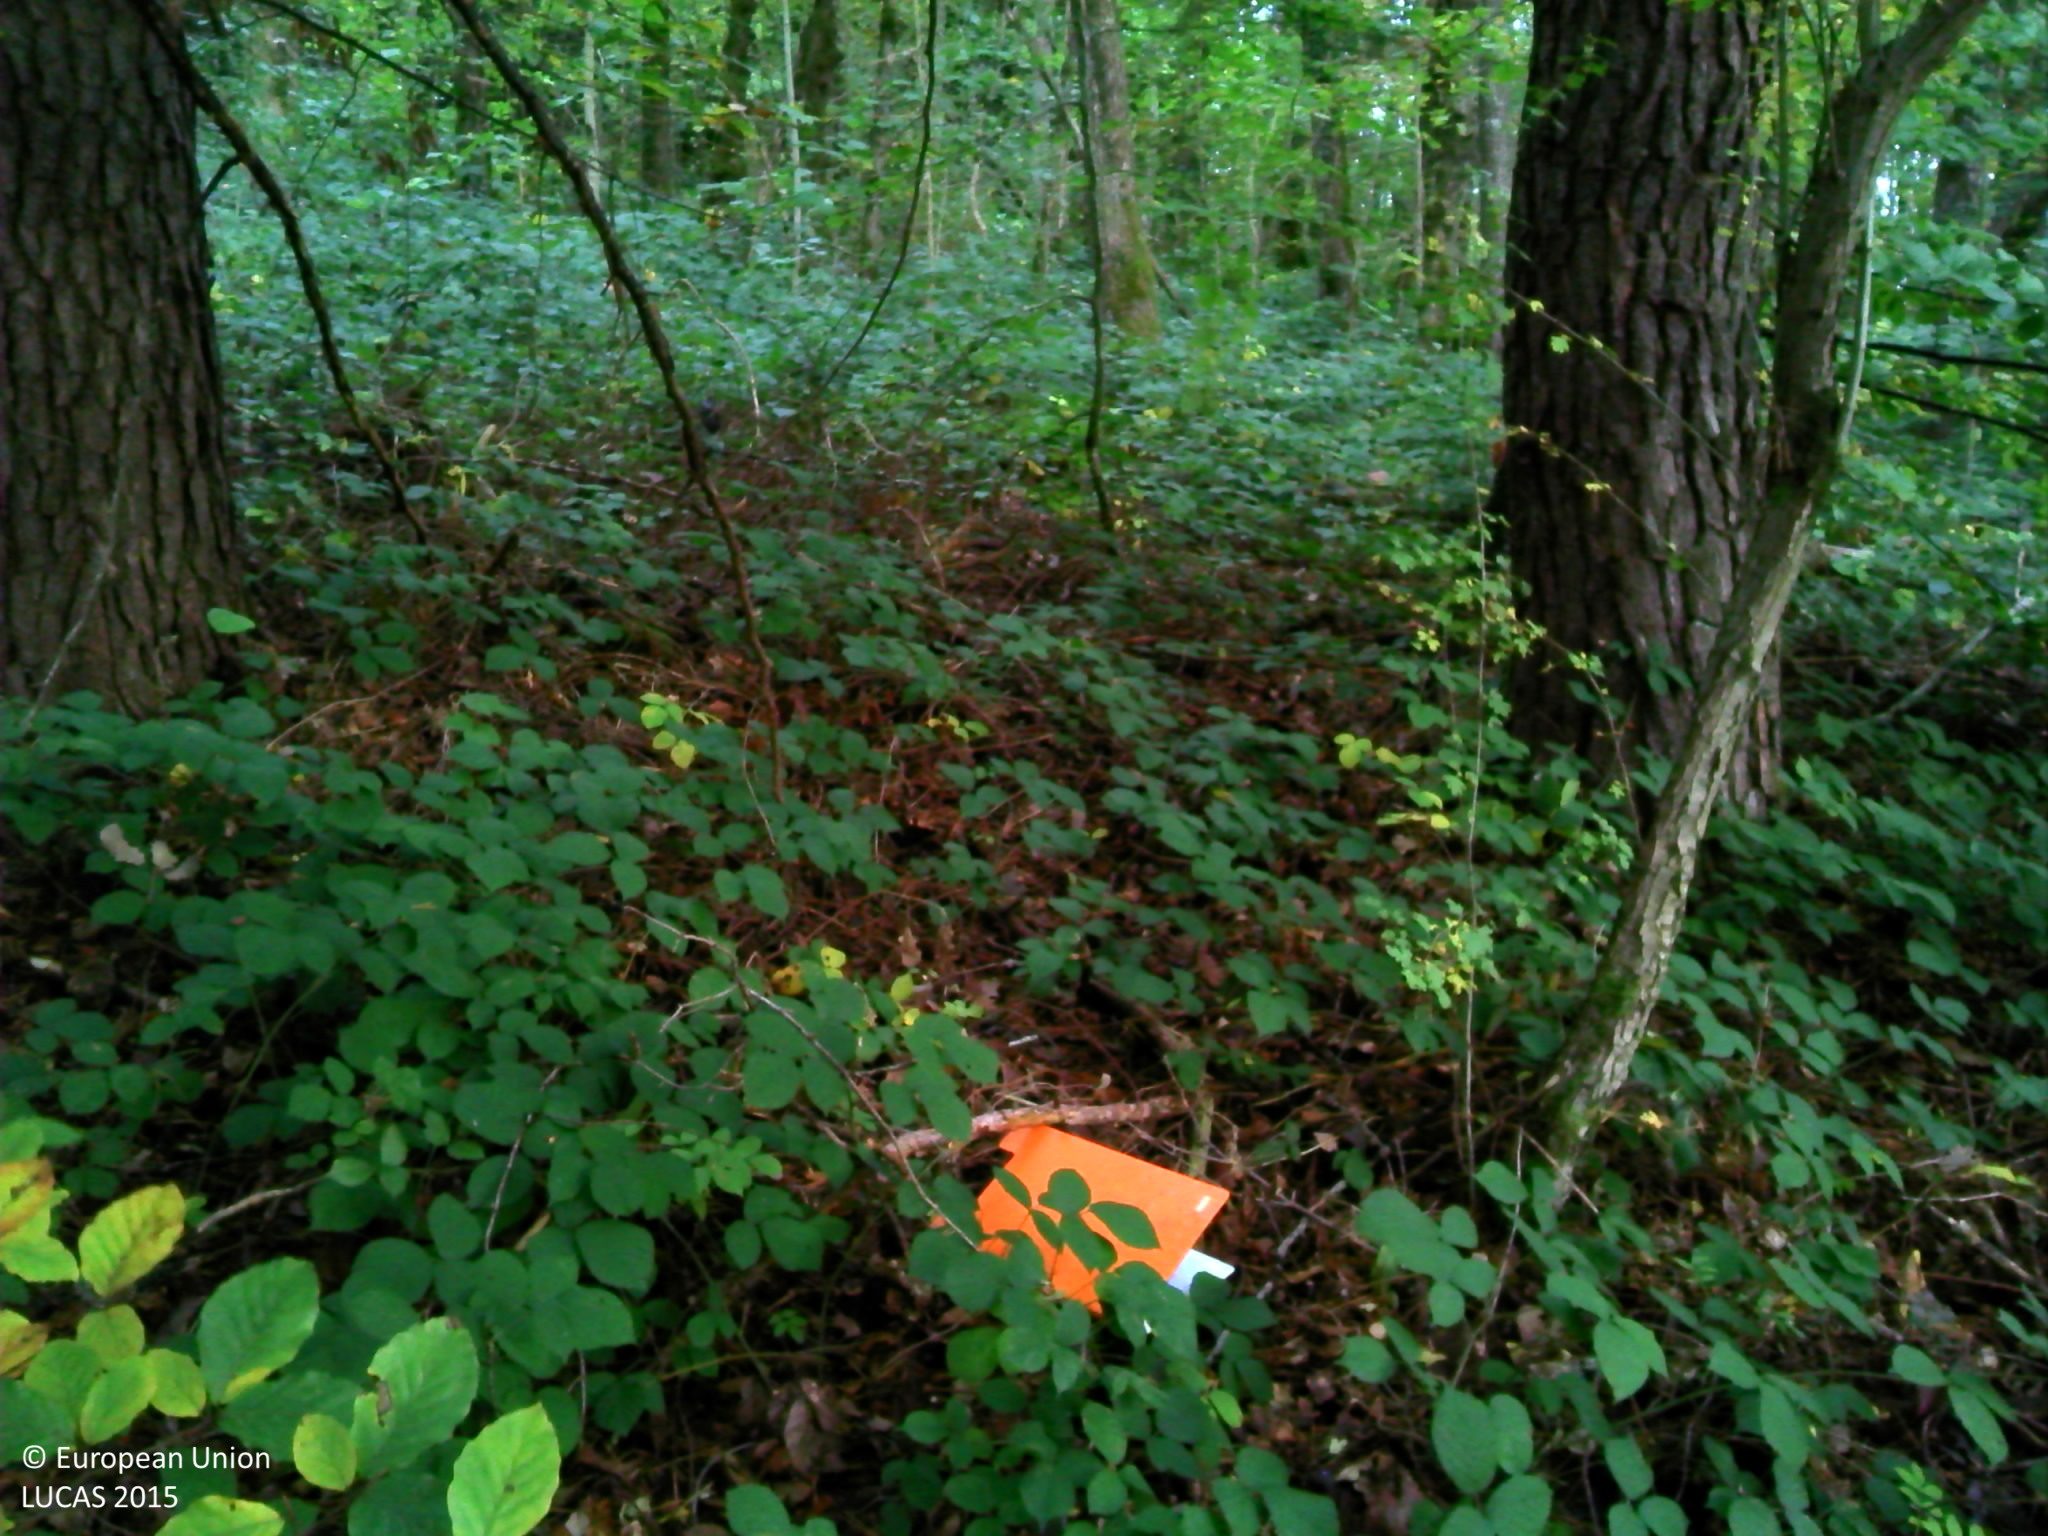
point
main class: Woodland
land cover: Broadleaved woodland
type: beech forest
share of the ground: > 75 %
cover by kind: broadleaved forest trees 90 %, shrubs 5 %, unconsolidated bare surface 5 %
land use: Forestry
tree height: > 5 m
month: October
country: FR
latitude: 47.1080
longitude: 6.0618
